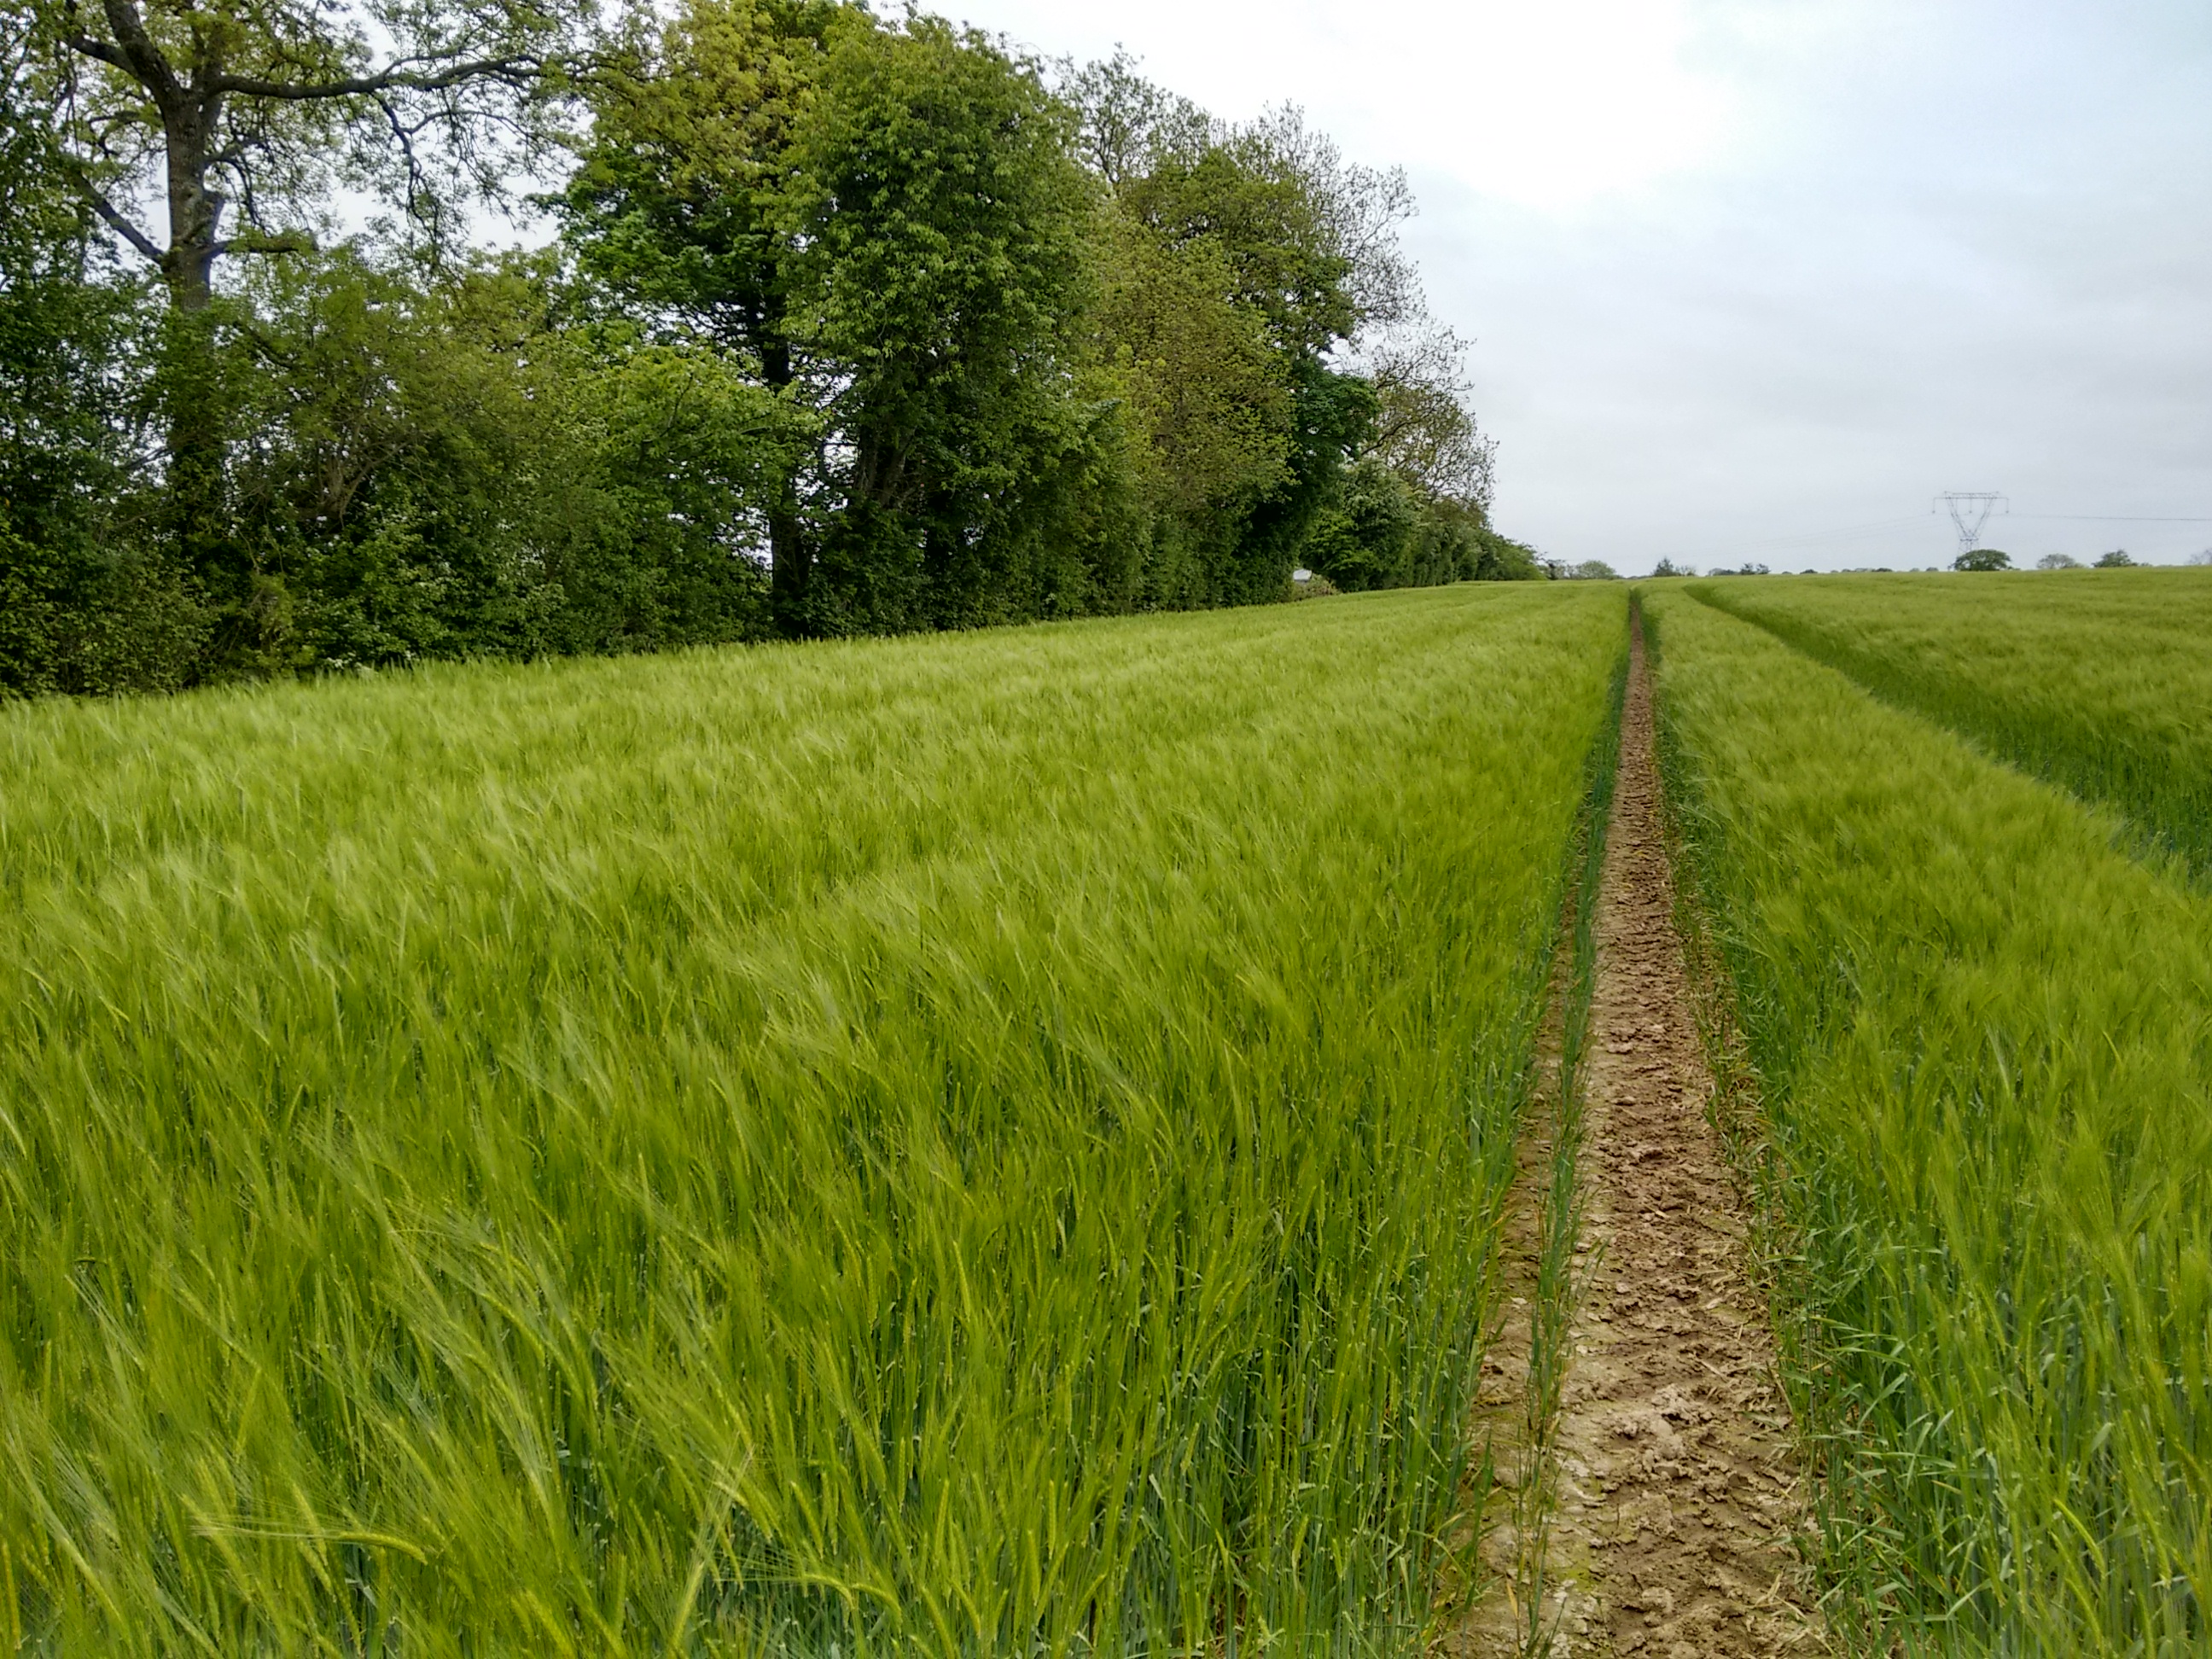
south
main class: Cropland
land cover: Barley
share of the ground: > 75 %
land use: Agriculture (excluding fallow land and kitchen gardens)
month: May
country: IE
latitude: 53.5419
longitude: -6.6551
